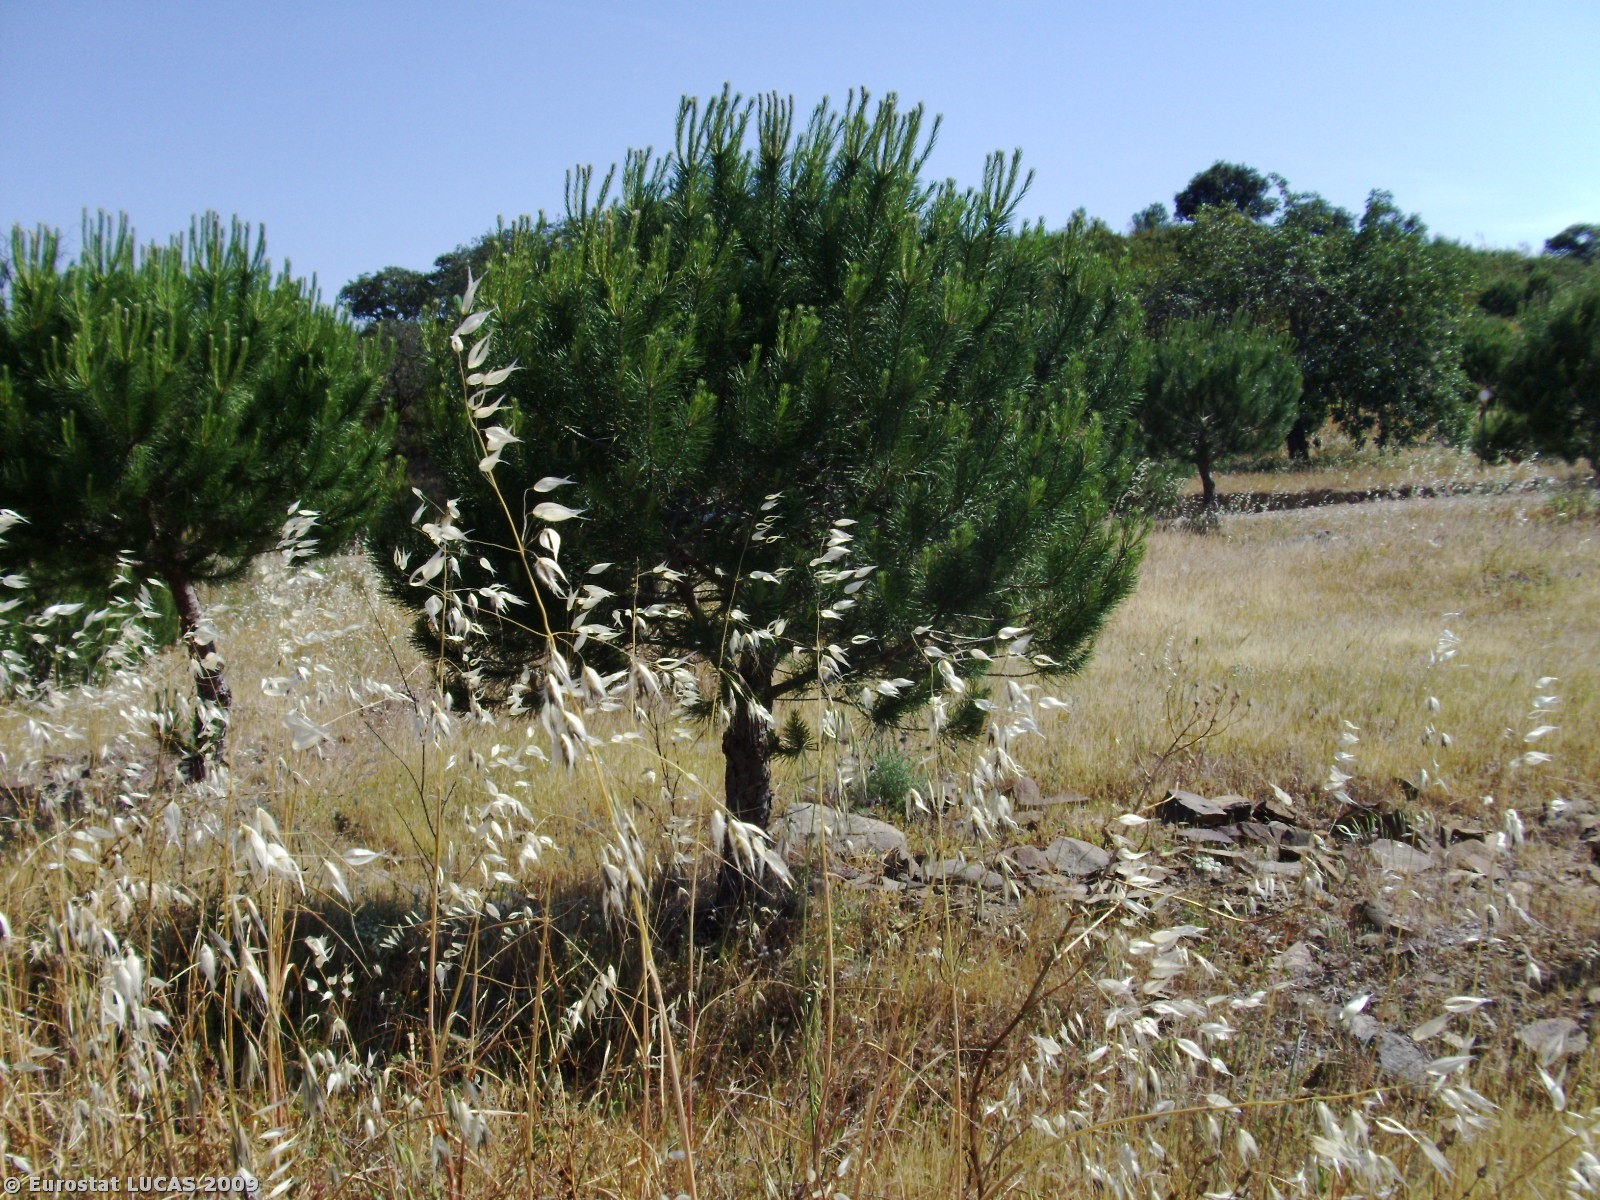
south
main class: Woodland
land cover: Coniferous woodland
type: coniferous forest of the mediterranean region
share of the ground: 10 - 25 %
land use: Forestry
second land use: Unused
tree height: > 5 m
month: May
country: PT
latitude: 37.4439
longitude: -7.4938
